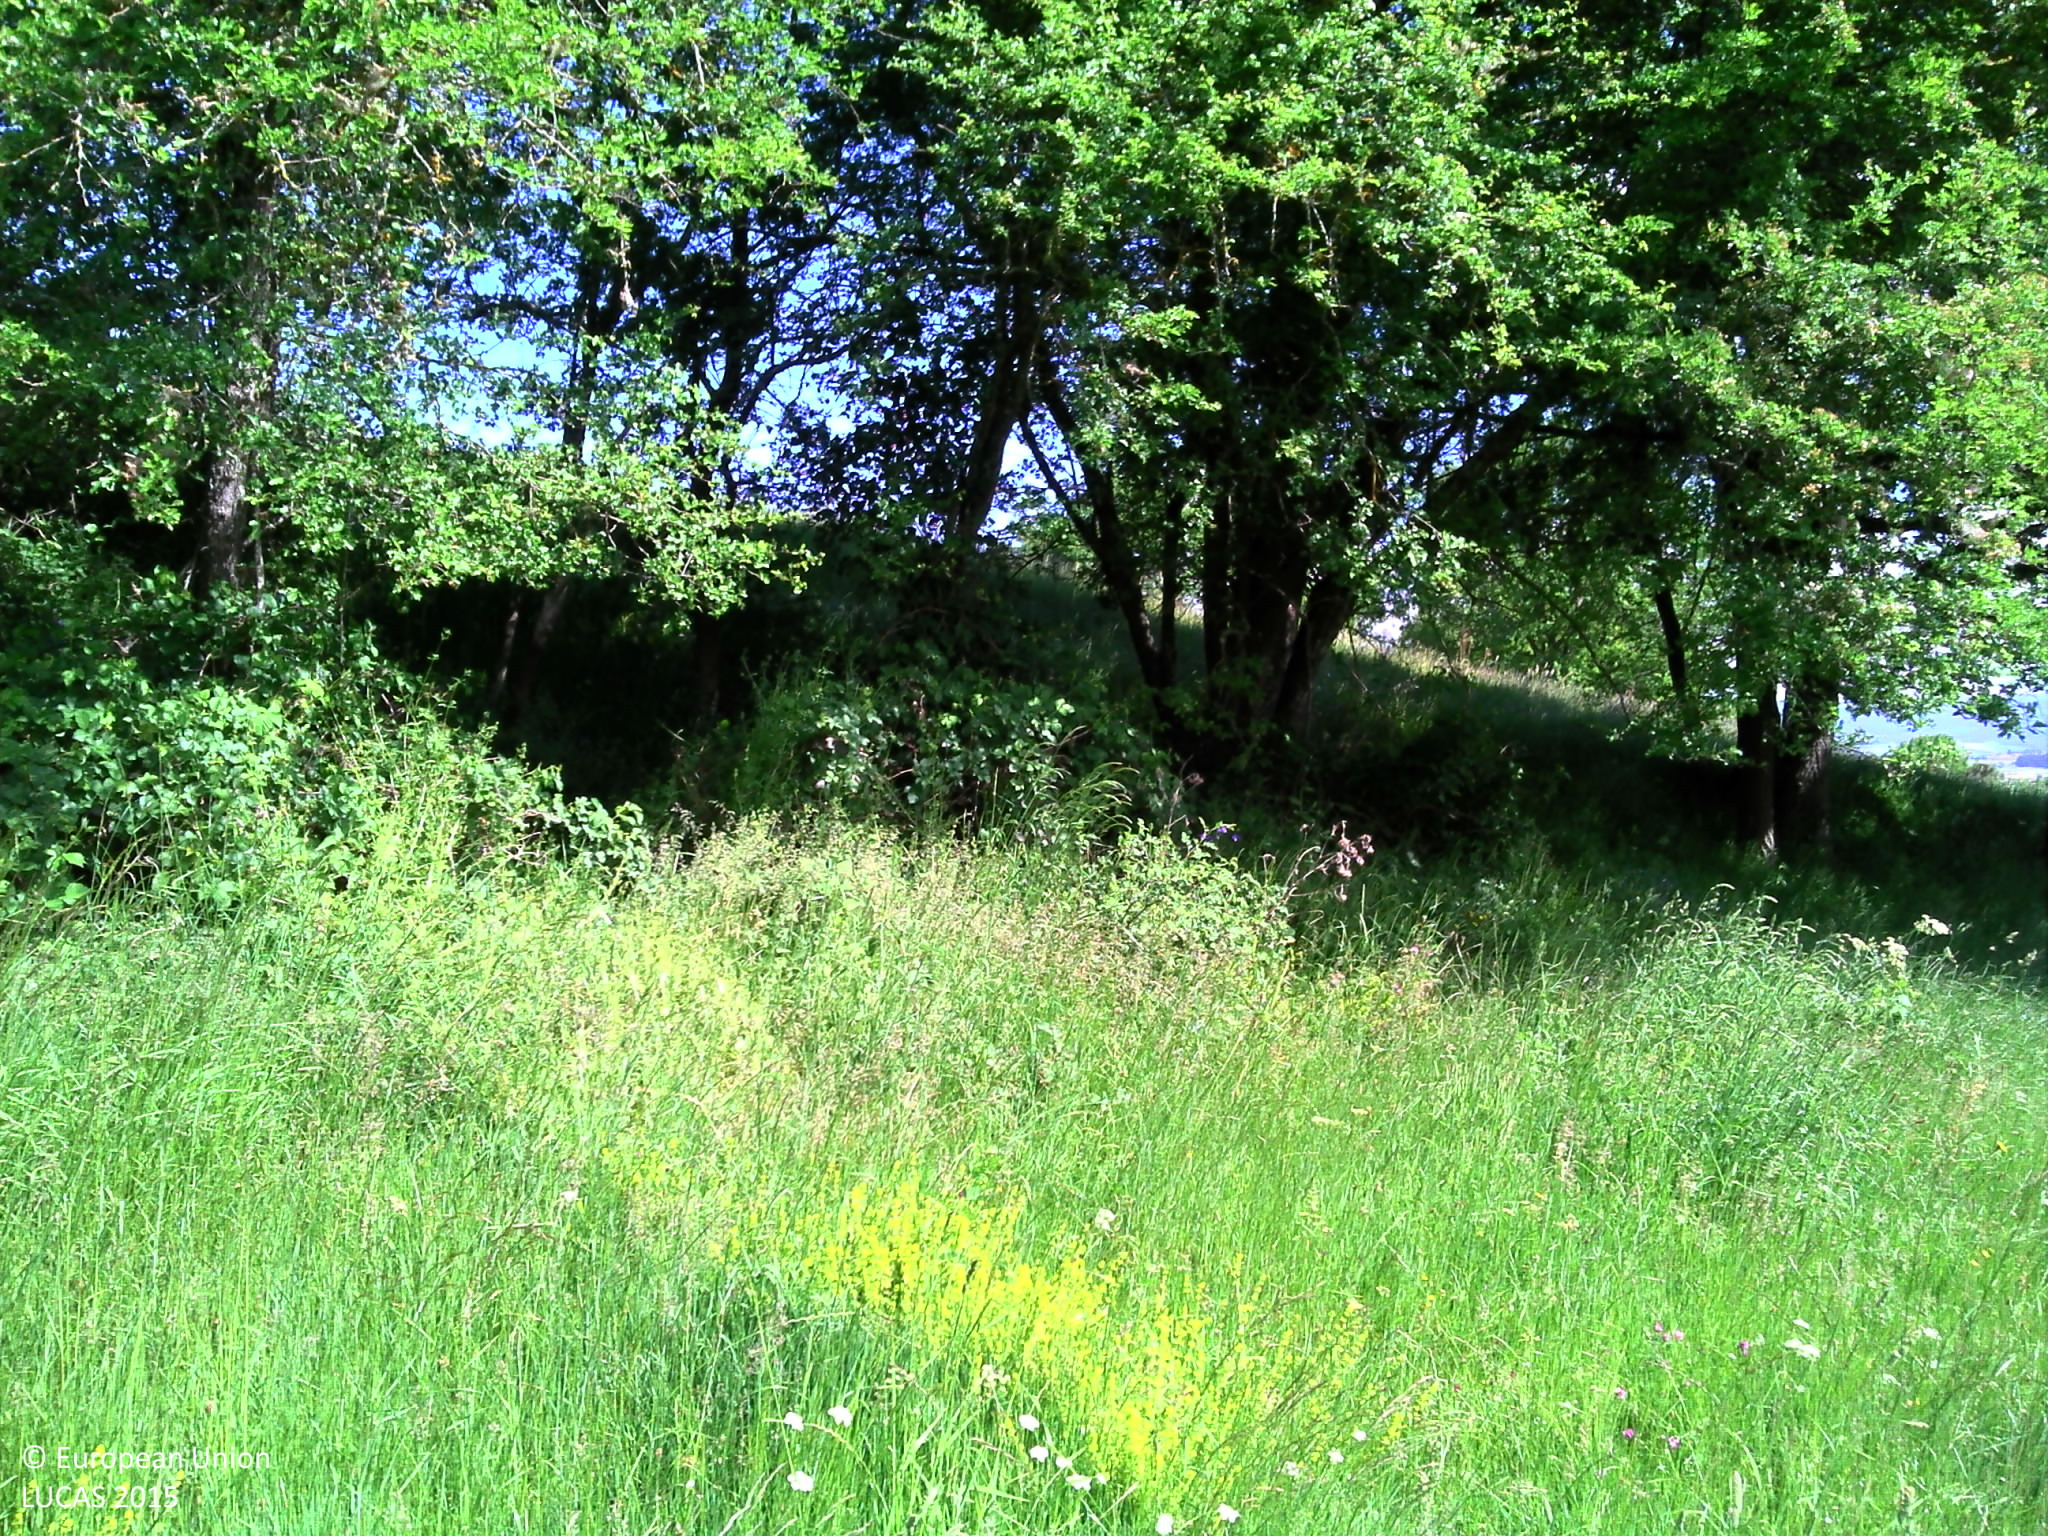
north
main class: Grassland
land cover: Grassland with sparse tree/shrub cover
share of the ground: > 75 %
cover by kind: herbaceous plants 95 %, broadleaved forest trees 5 %
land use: Agriculture (excluding fallow land and kitchen gardens)
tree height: > 5 m
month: June
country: FR
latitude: 44.9430
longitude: 3.2228
